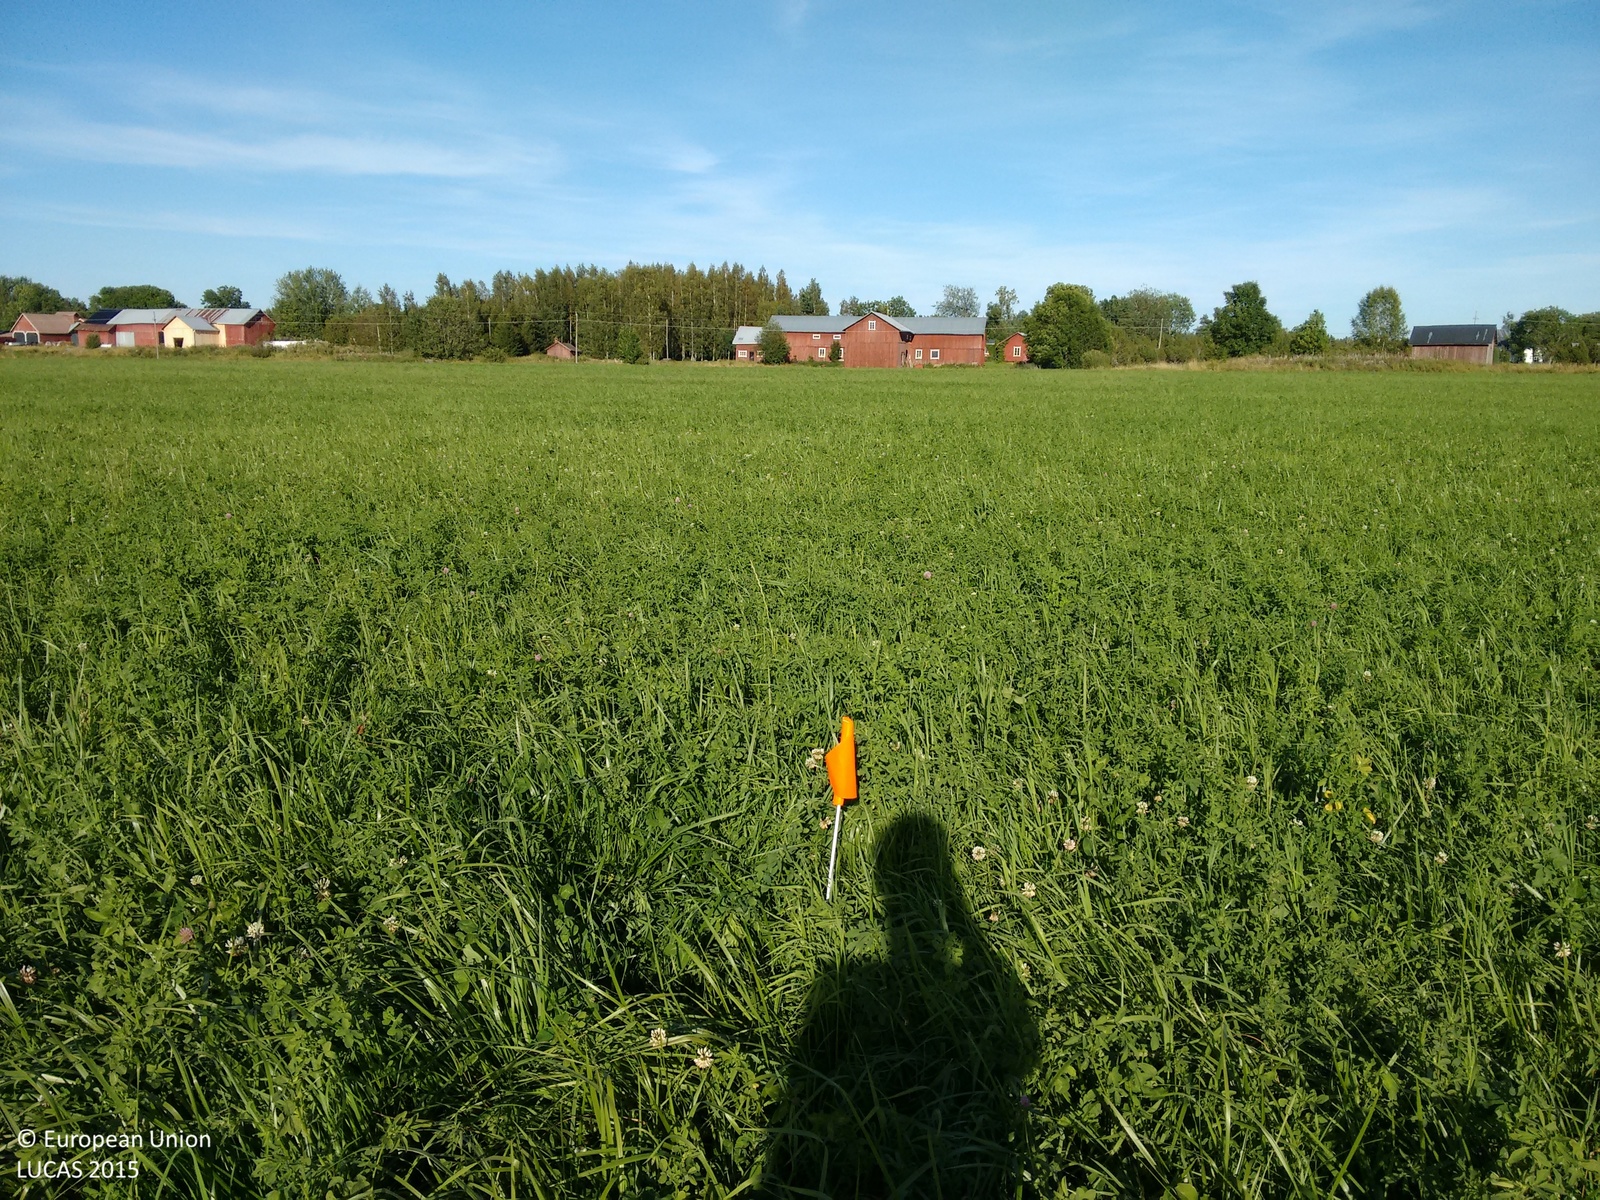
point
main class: Cropland
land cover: Temporary grasslands
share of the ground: > 75 %
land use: Agriculture (excluding fallow land and kitchen gardens)
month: August
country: FI
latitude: 60.1944
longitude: 19.9079
